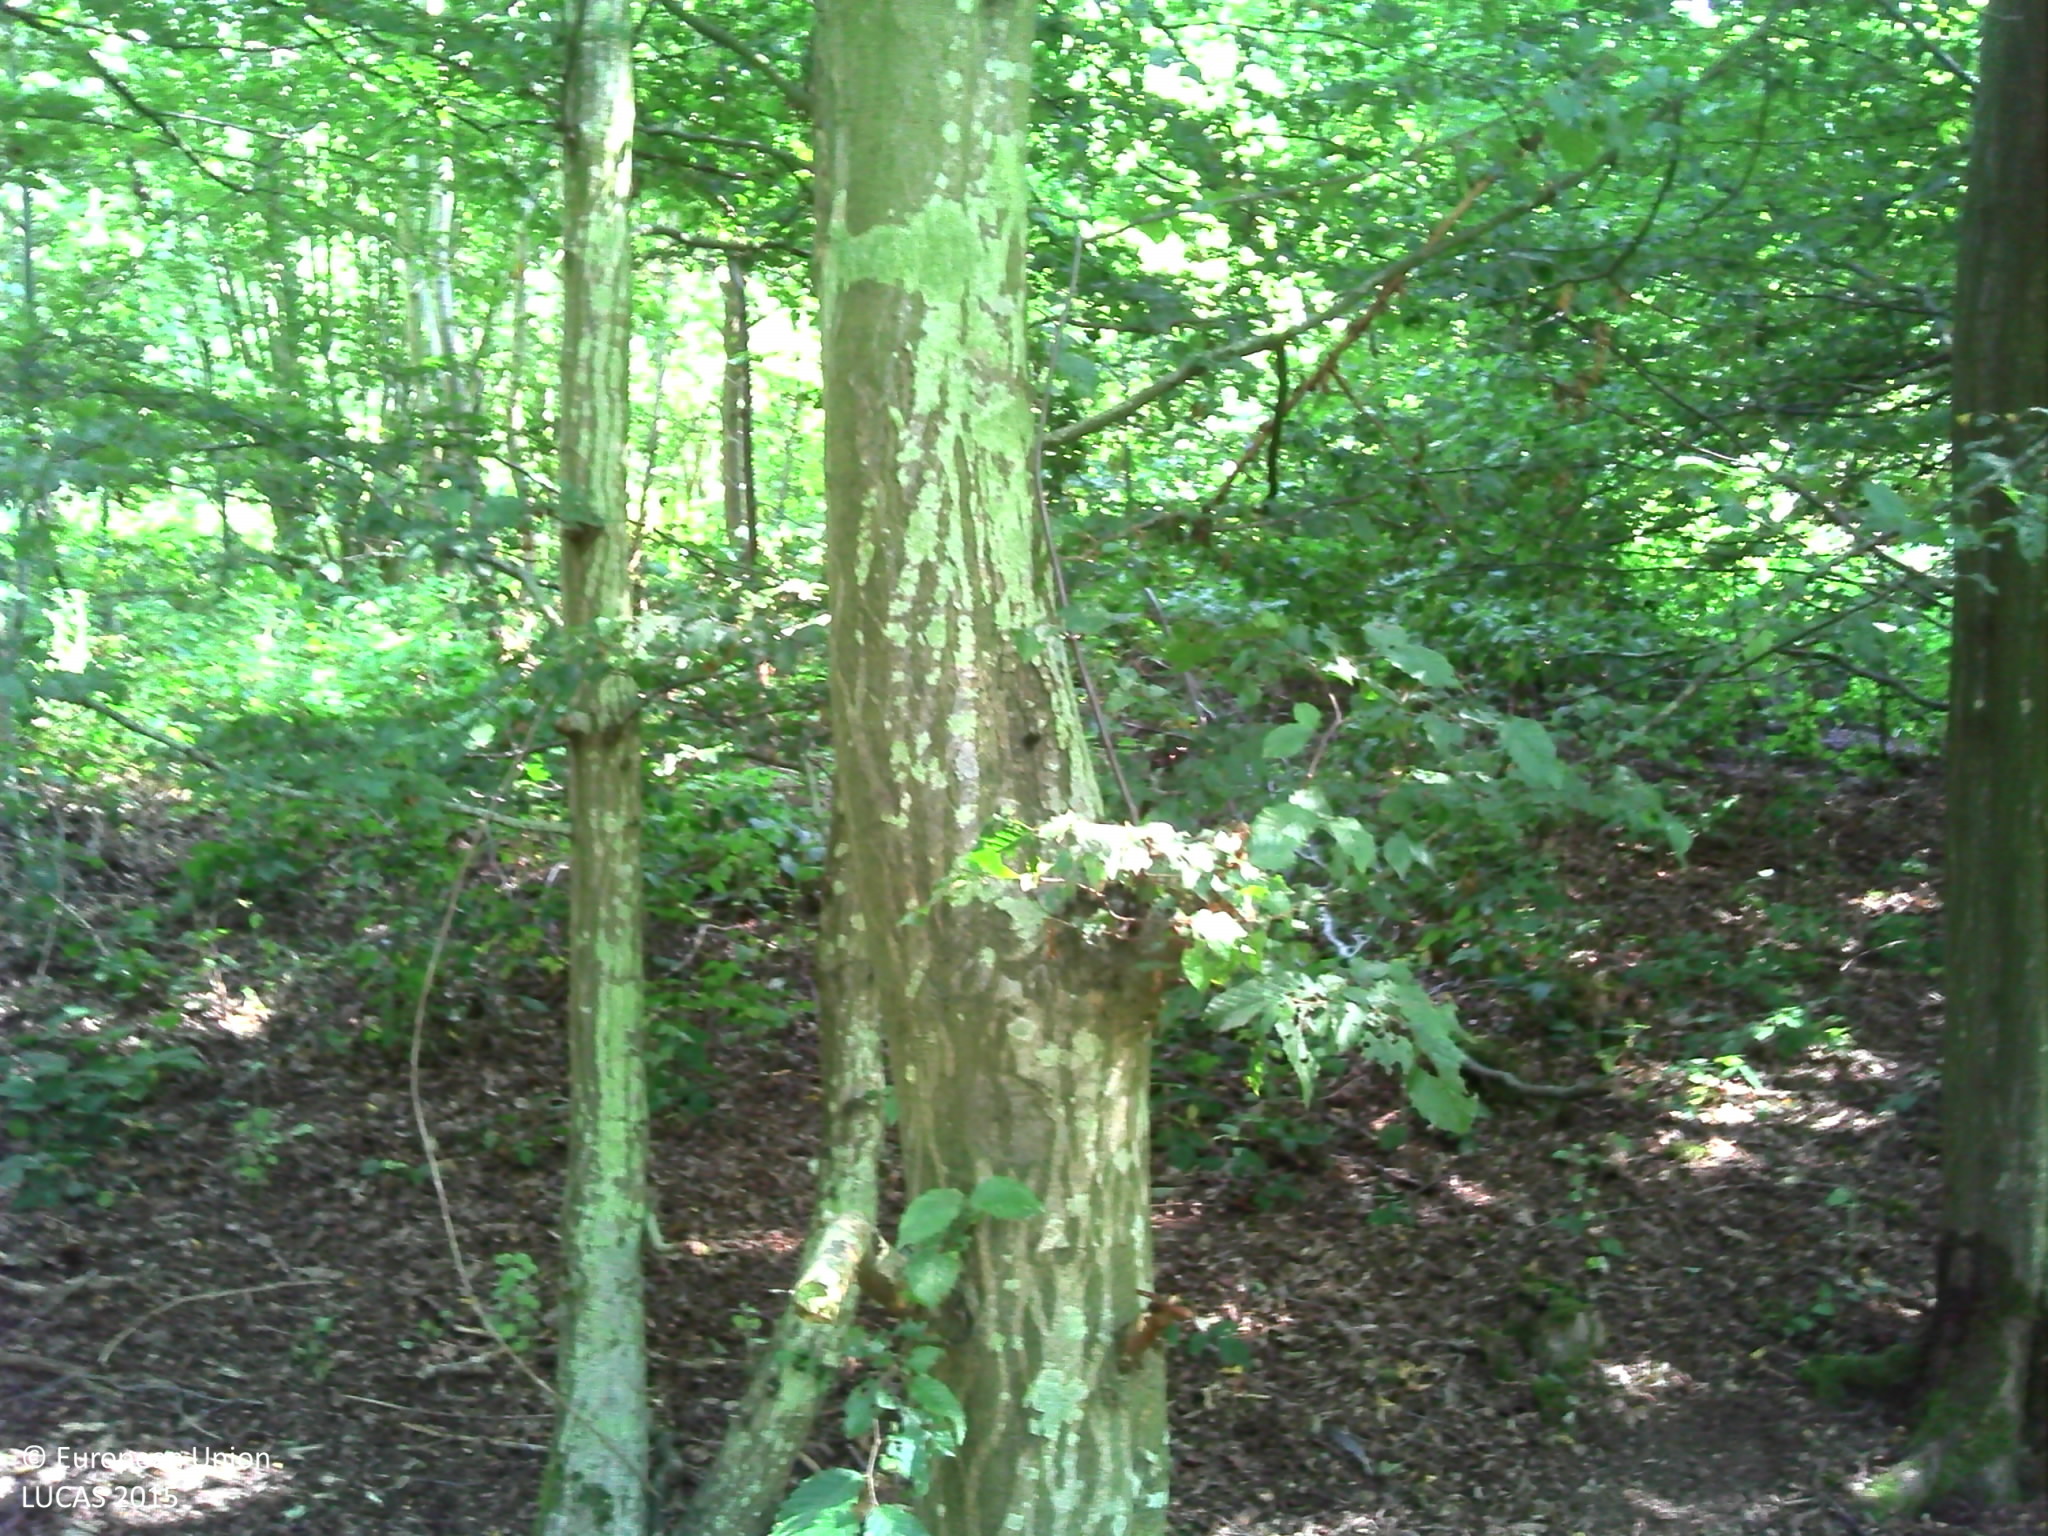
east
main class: Woodland
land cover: Broadleaved woodland
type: mesophytic deciduous forest
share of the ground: > 75 %
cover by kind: broadleaved forest trees 90 %, lichens and mosses 5 %, unconsolidated bare surface 5 %
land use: Forestry
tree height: > 5 m
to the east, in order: Broadleaved woodland; Grassland without tree/shrub cover; Broadleaved woodland; Other fibre and oleaginous crops
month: August
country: FR
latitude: 50.8615
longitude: 2.0139
